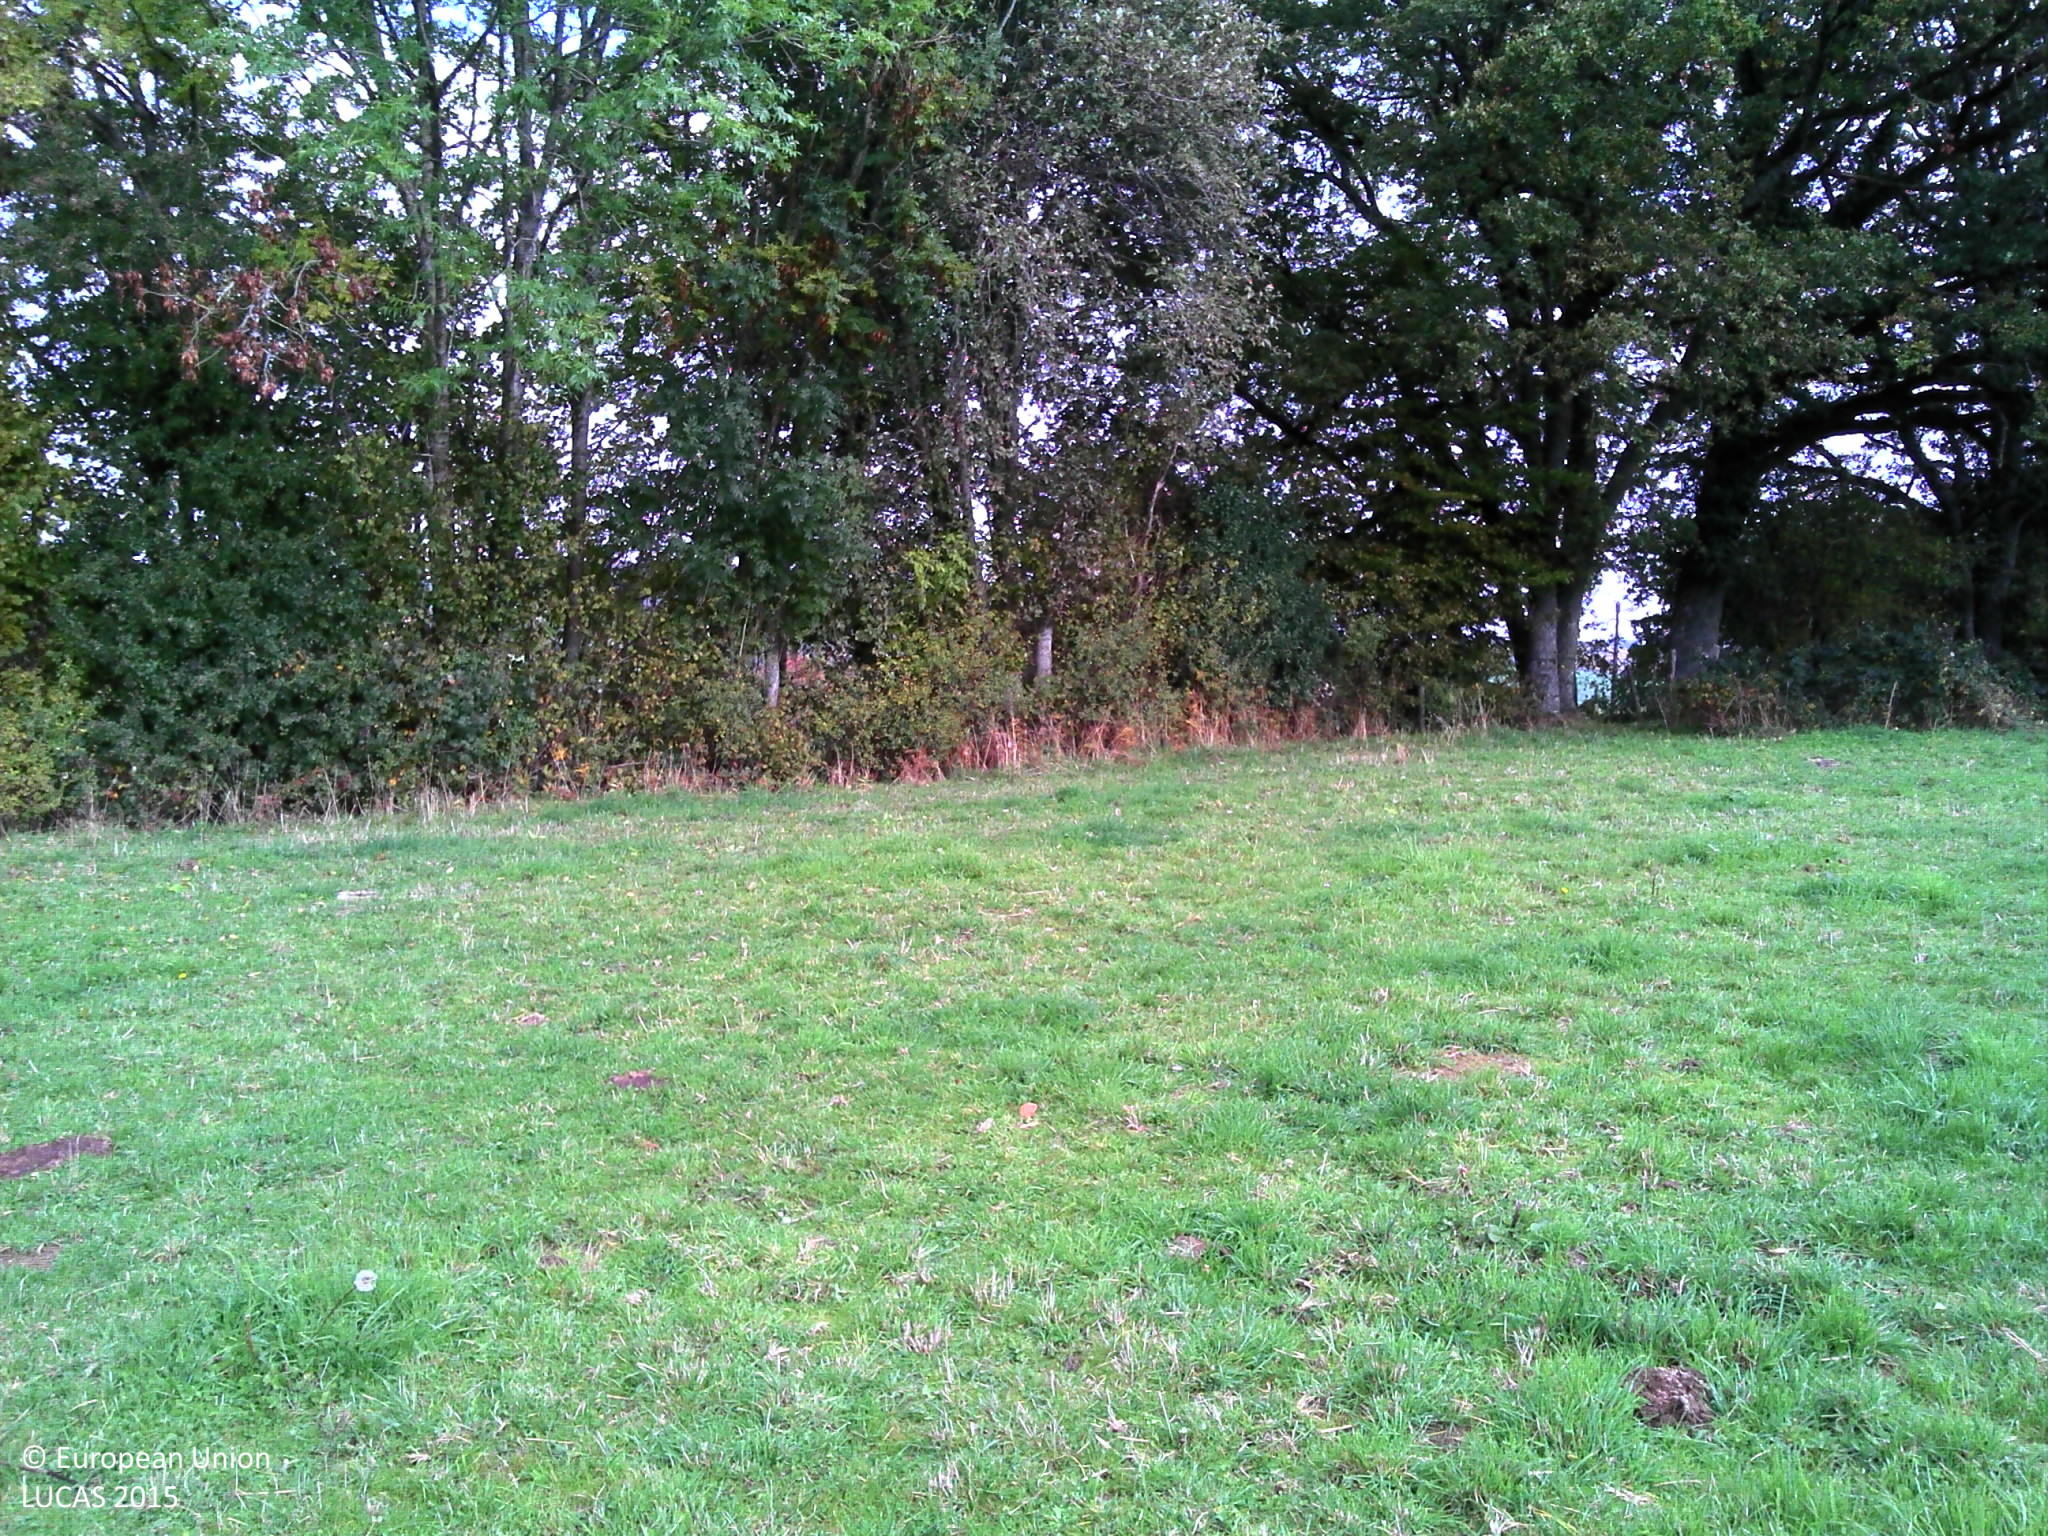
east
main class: Grassland
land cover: Grassland without tree/shrub cover
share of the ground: > 75 %
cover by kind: herbaceous plants 100 %
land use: Agriculture (excluding fallow land and kitchen gardens)
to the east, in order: Grassland without tree/shrub cover; Fences; Abandoned hedges; Grassland without tree/shrub cover; Electric lines; Grassland without tree/shrub cover
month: October
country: FR
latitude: 46.0737
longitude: 2.8218
